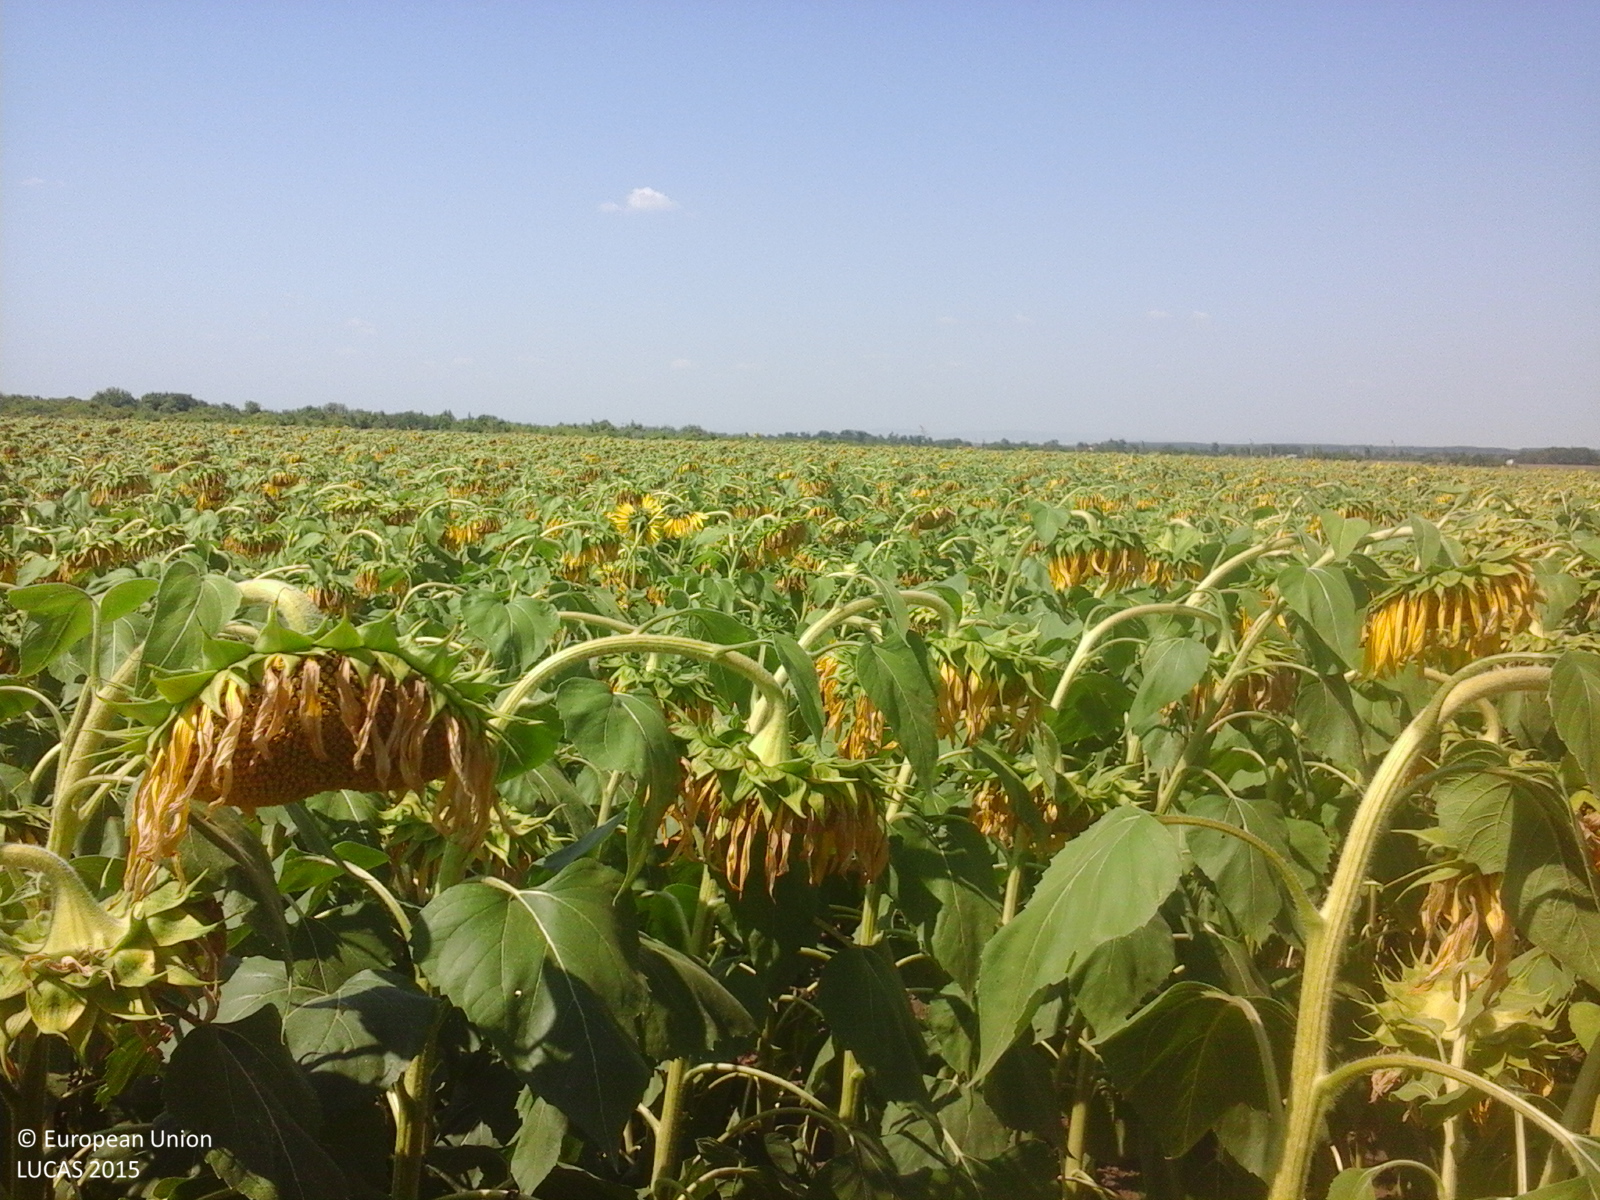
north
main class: Cropland
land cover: Sunflower
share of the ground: > 75 %
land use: Agriculture (excluding fallow land and kitchen gardens)
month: July
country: RO
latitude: 45.0080
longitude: 26.8133
